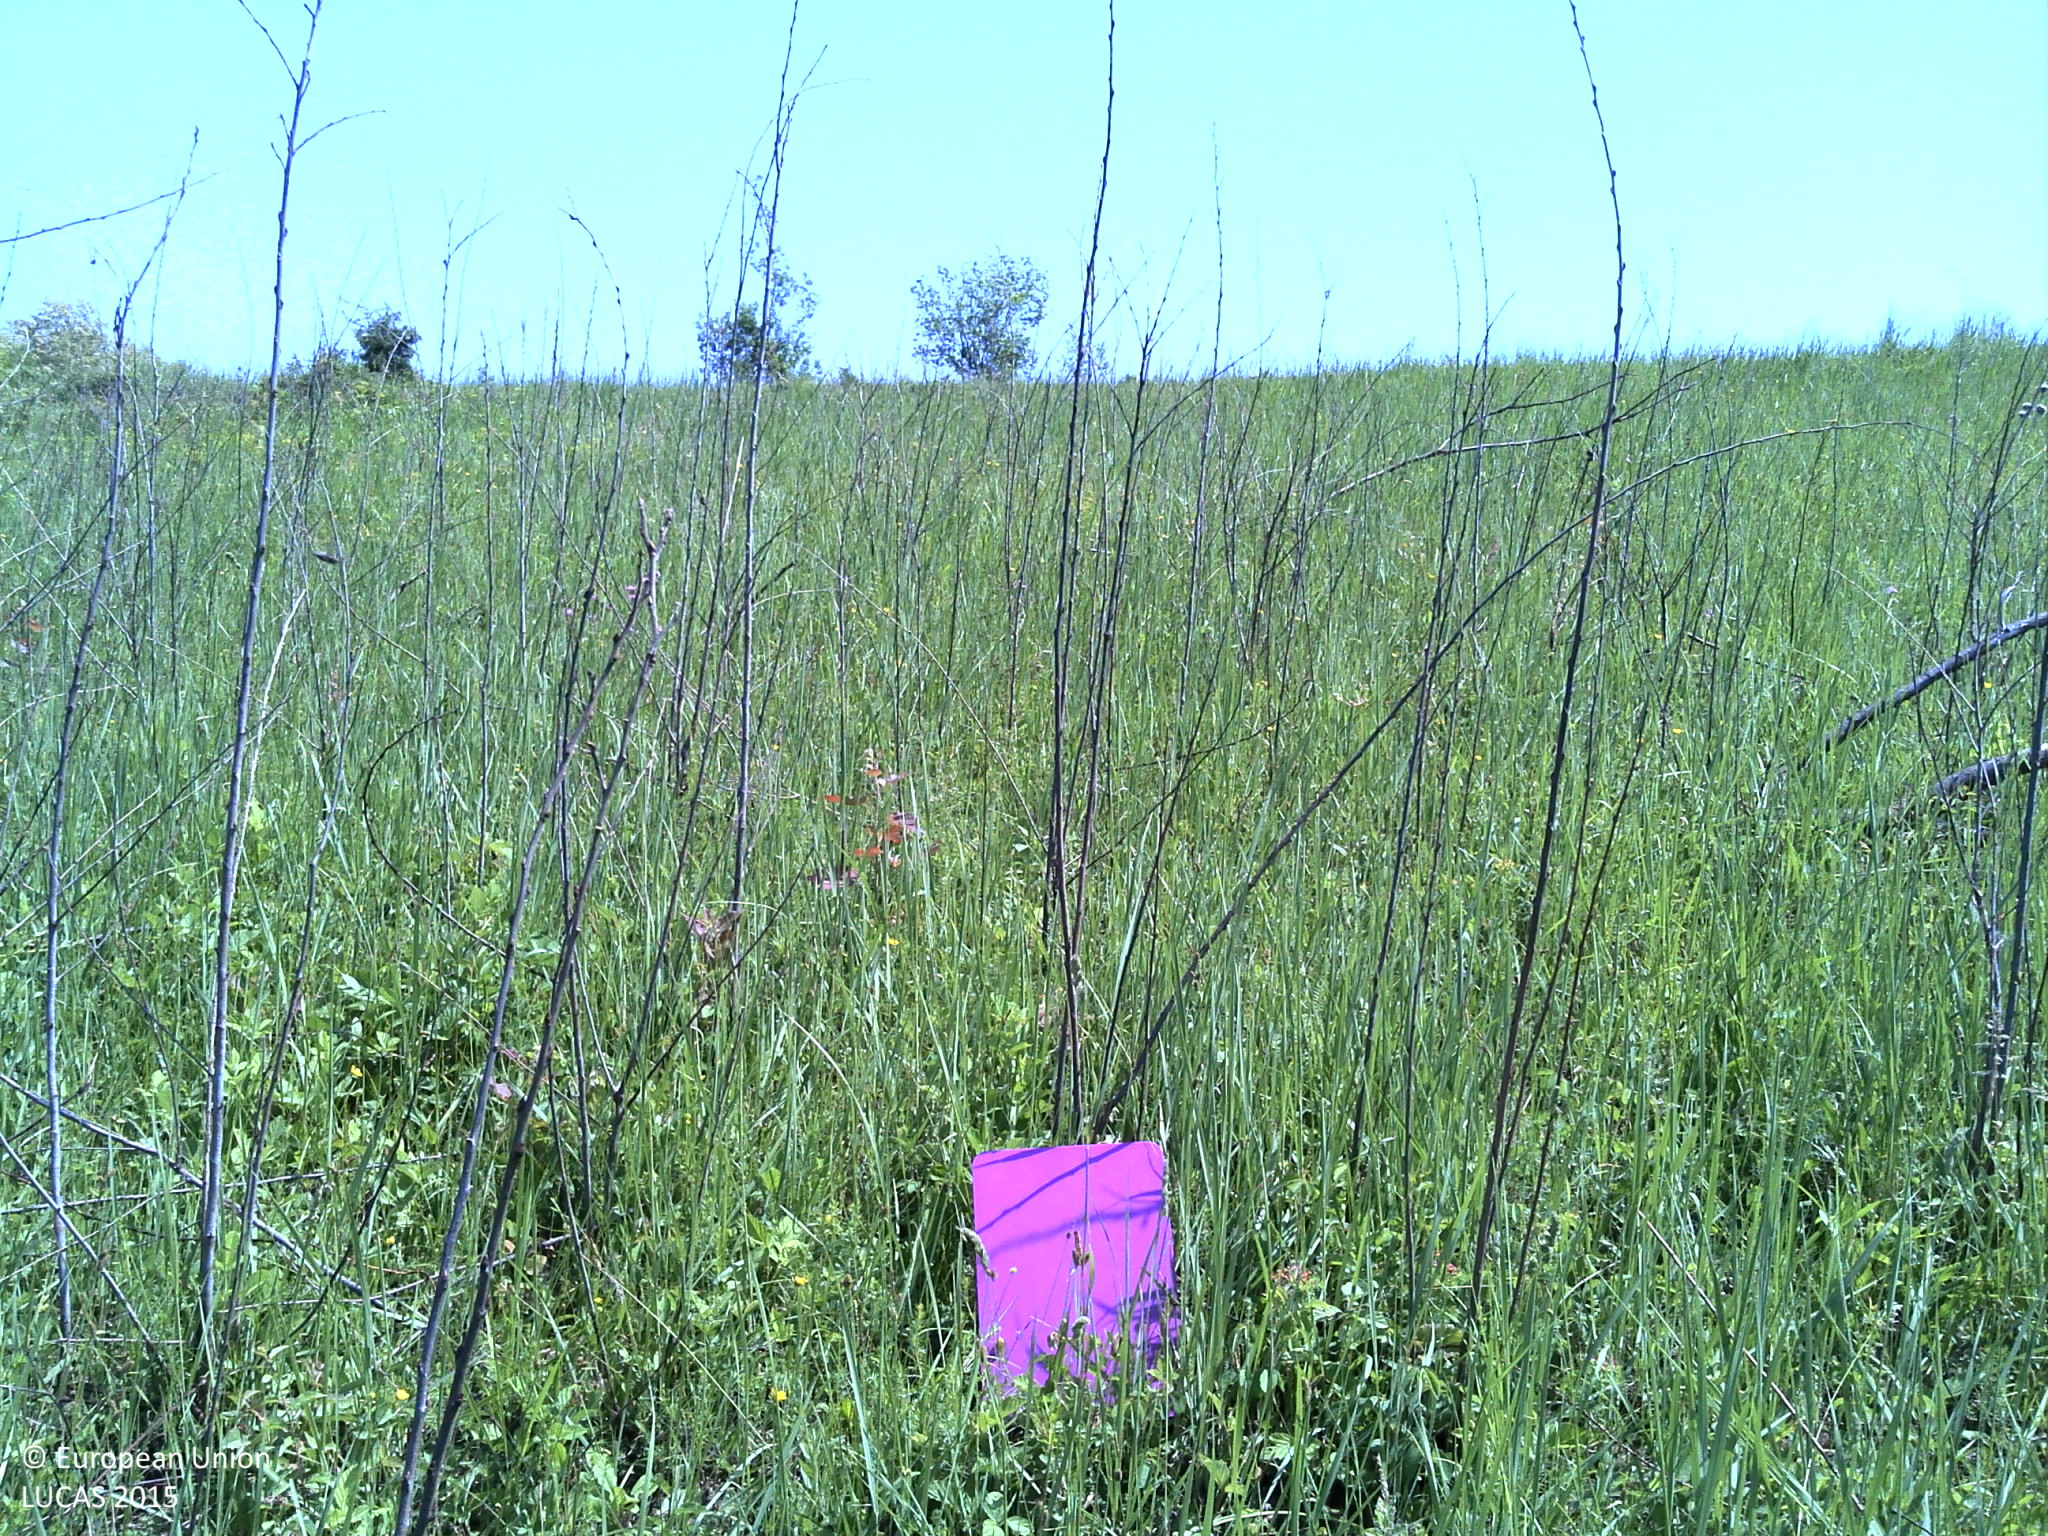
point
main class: Grassland
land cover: Spontaneously vegetated surfaces
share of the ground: > 75 %
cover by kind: herbaceous plants 95 %, shrubs 5 %
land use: Semi-natural and natural areas not in use
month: May
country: HR
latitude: 45.3909
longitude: 18.1147
